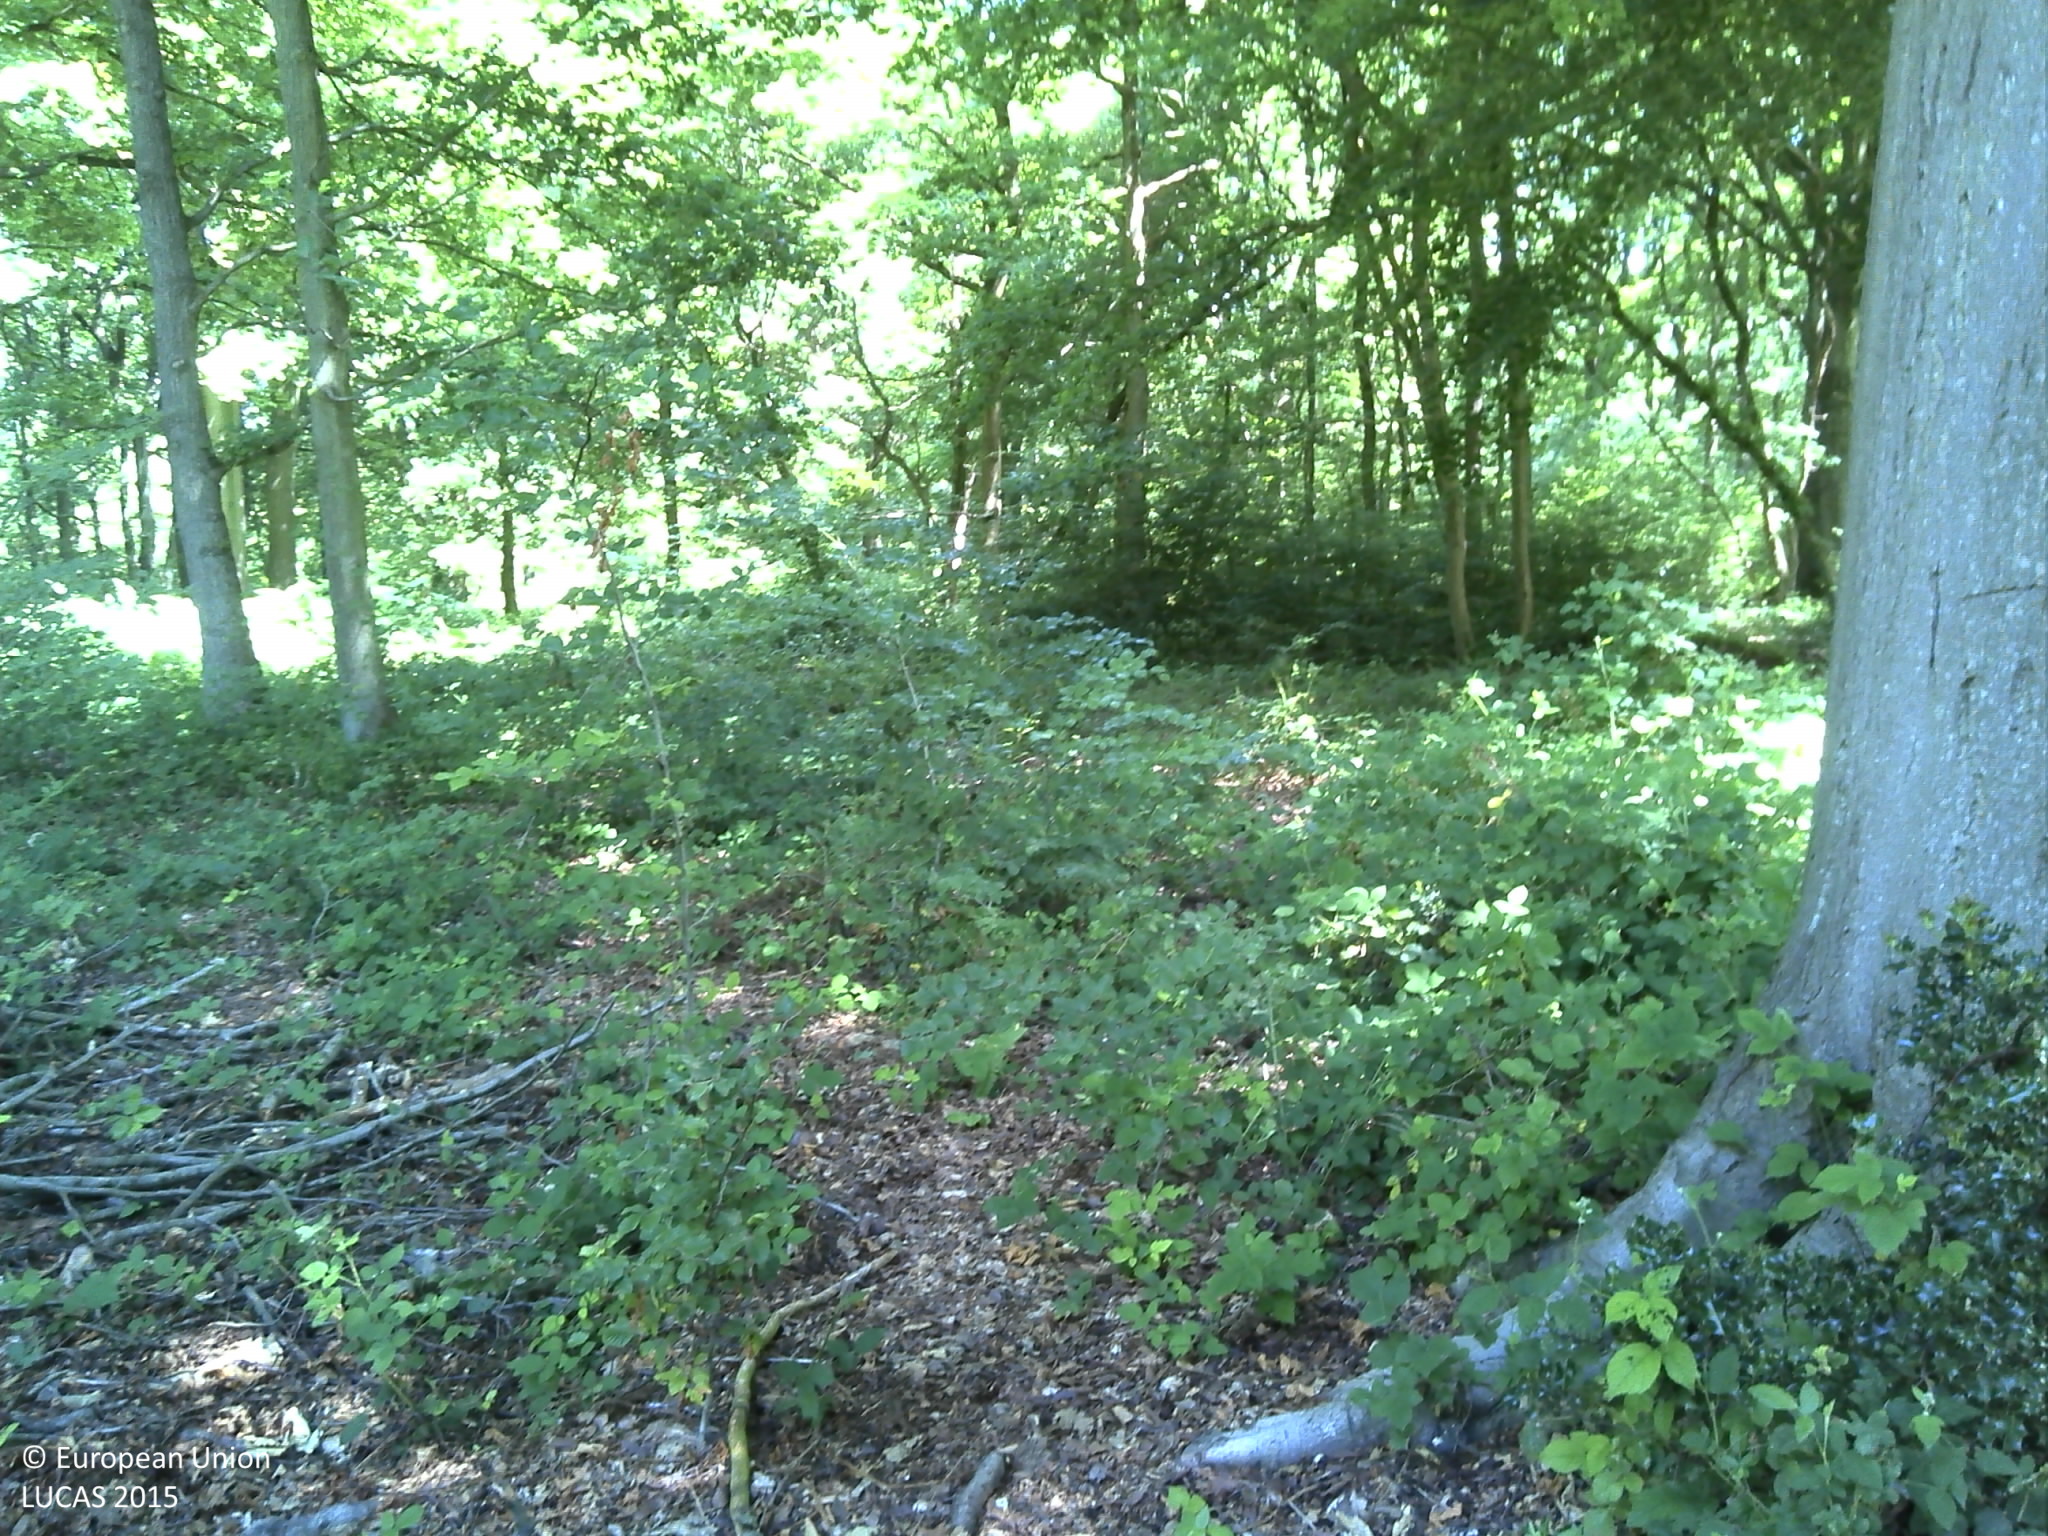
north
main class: Woodland
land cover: Broadleaved woodland
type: acidophilous oak and oak-birch forest
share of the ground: > 75 %
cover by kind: broadleaved forest trees 100 %
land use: Forestry
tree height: > 5 m
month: June
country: FR
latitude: 49.4297
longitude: 1.0017
